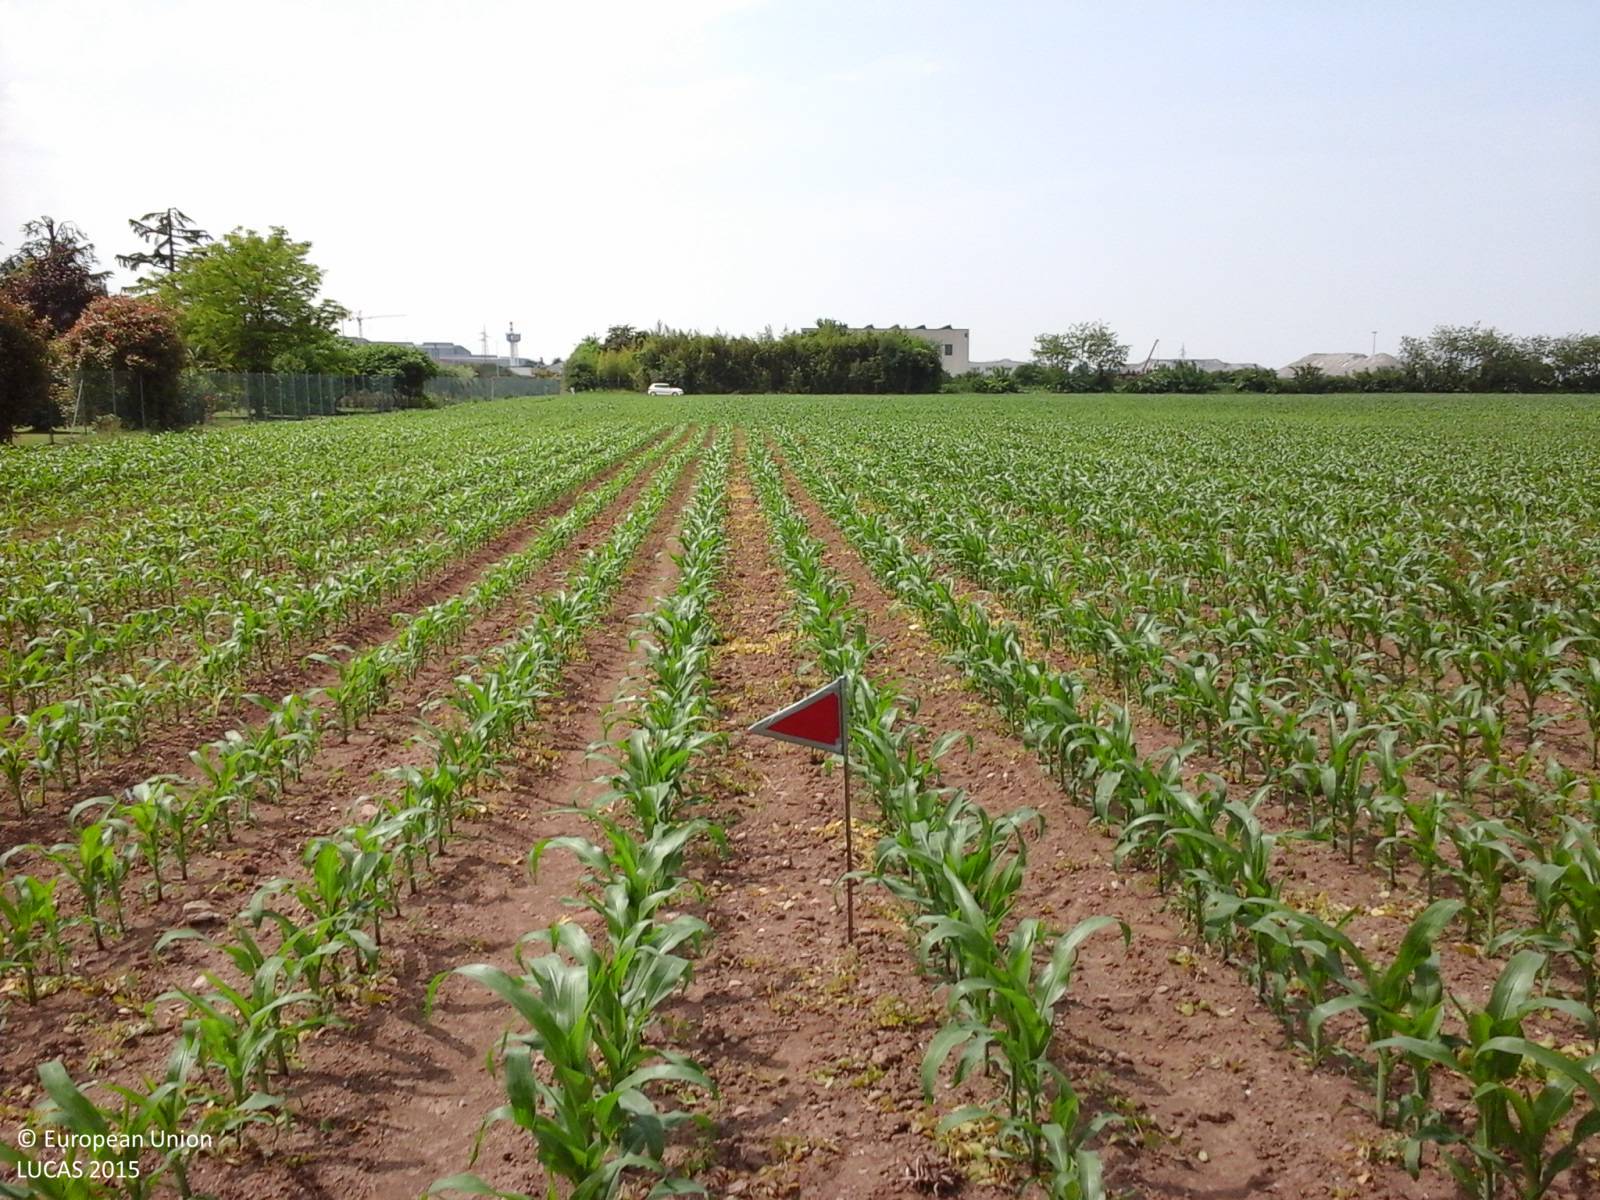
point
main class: Cropland
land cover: Maize
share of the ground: 50 - 75 %
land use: Agriculture (excluding fallow land and kitchen gardens)
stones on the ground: < 10 %
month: May
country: IT
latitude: 46.0130
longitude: 13.2639
